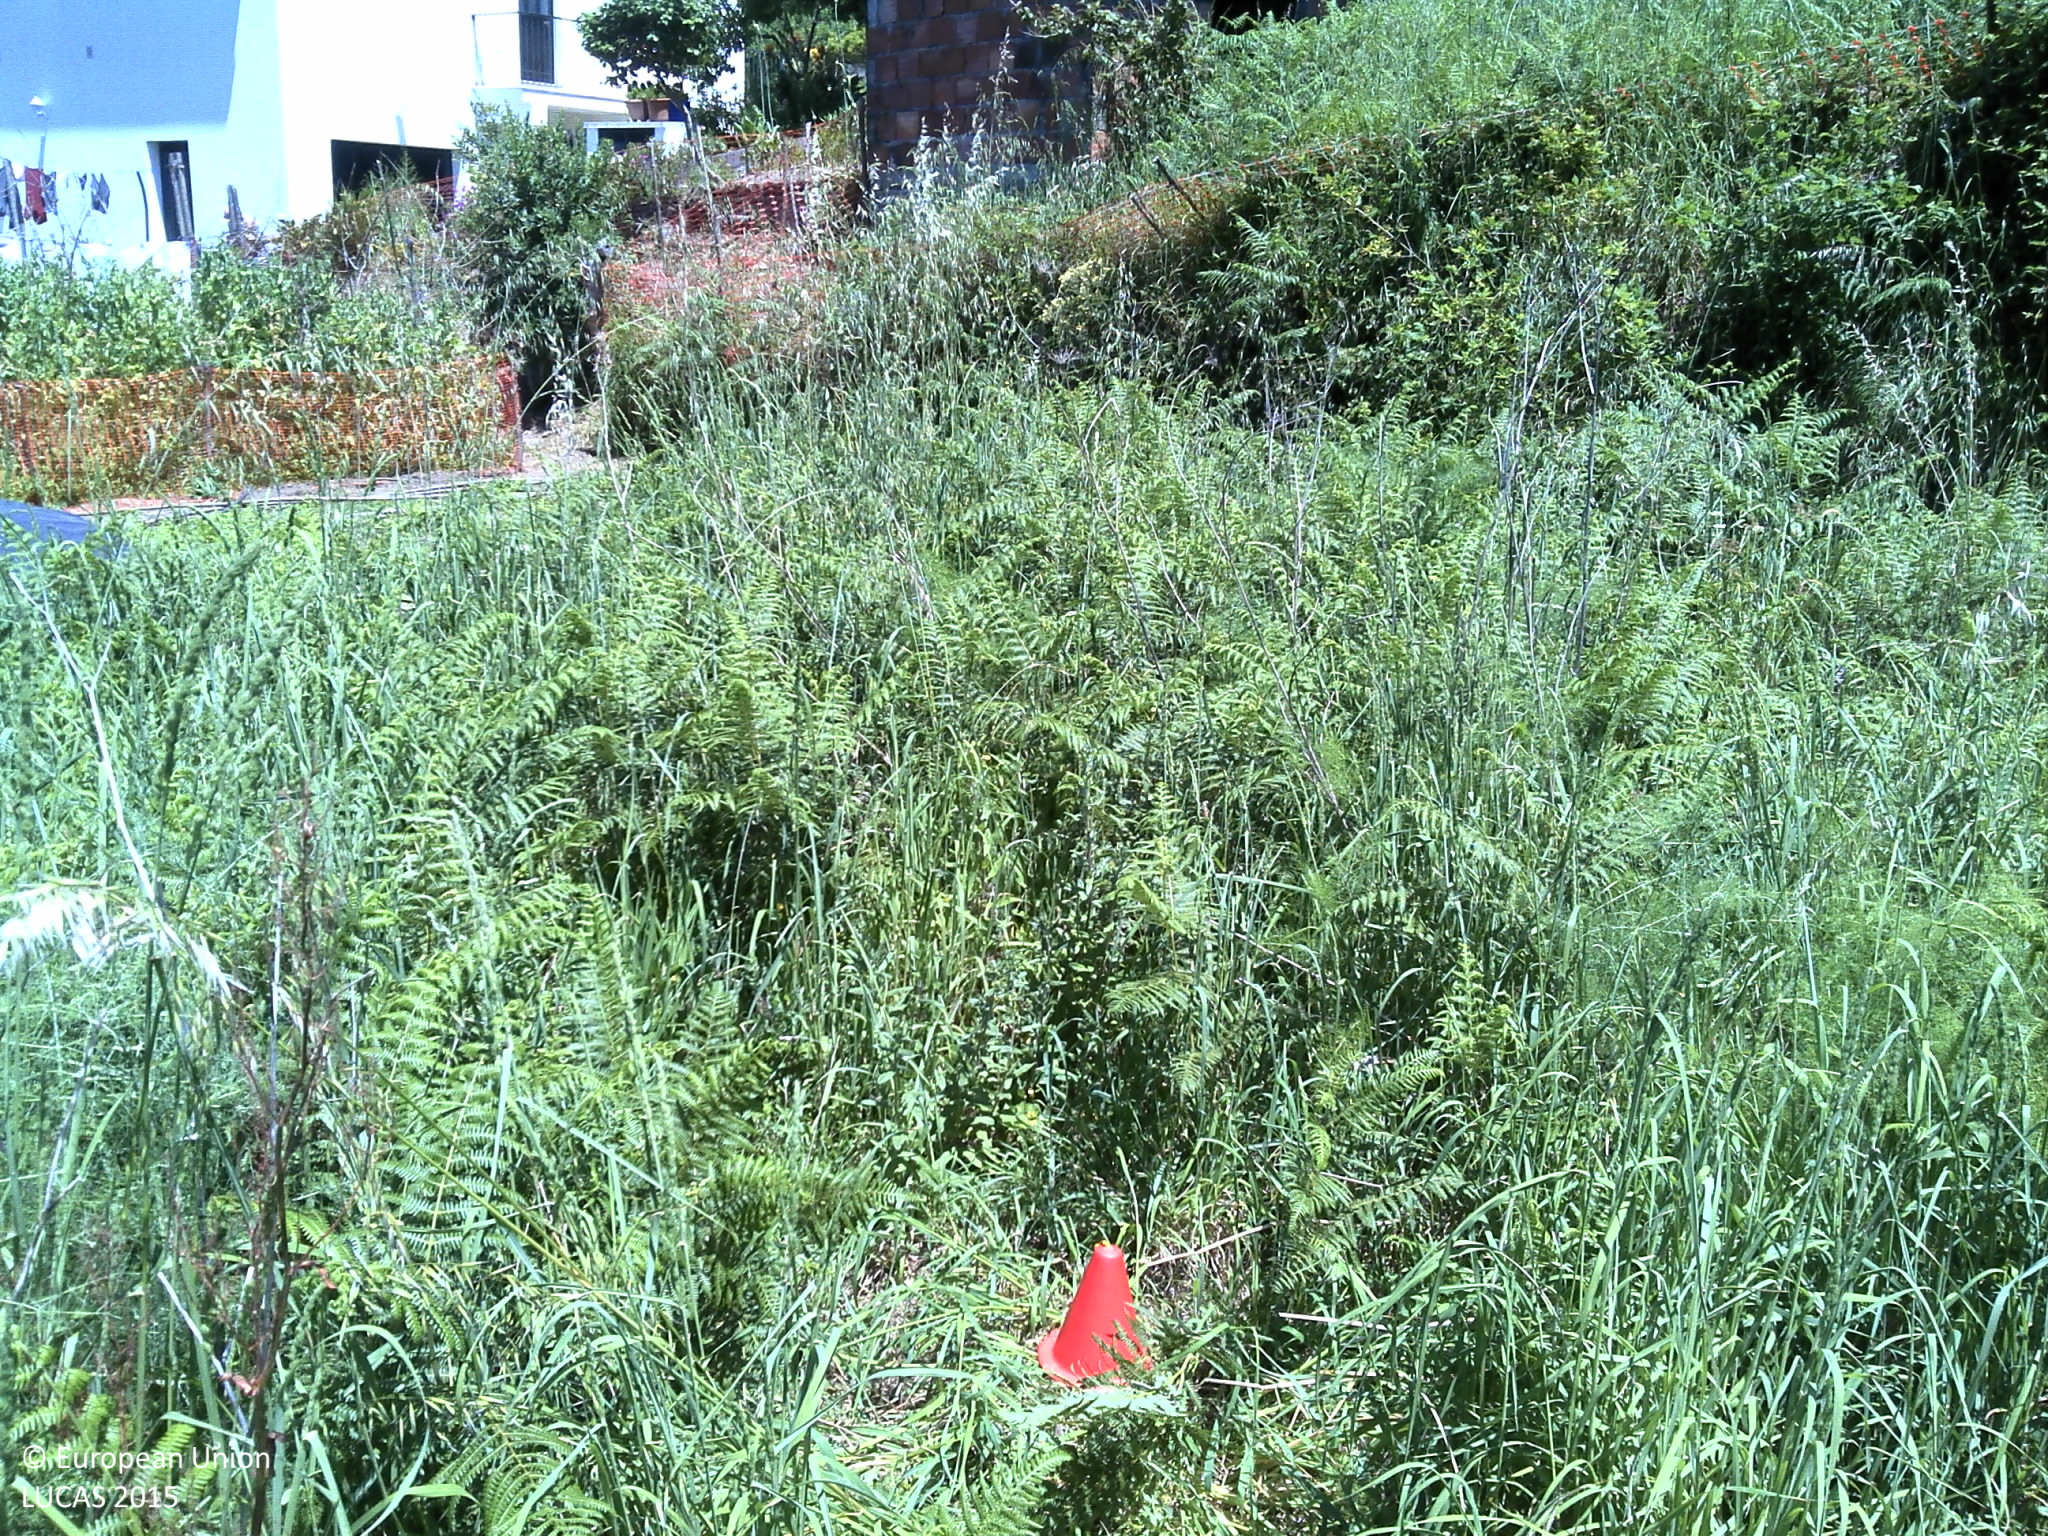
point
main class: Shrubland
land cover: Shrubland without tree cover
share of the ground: 50 - 75 %
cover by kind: shrubs 50 %, herbaceous plants 40 %, unconsolidated bare surface 10 %
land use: Abandoned areas
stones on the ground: < 10 %
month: May
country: PT
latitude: 41.9197
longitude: -8.7506
